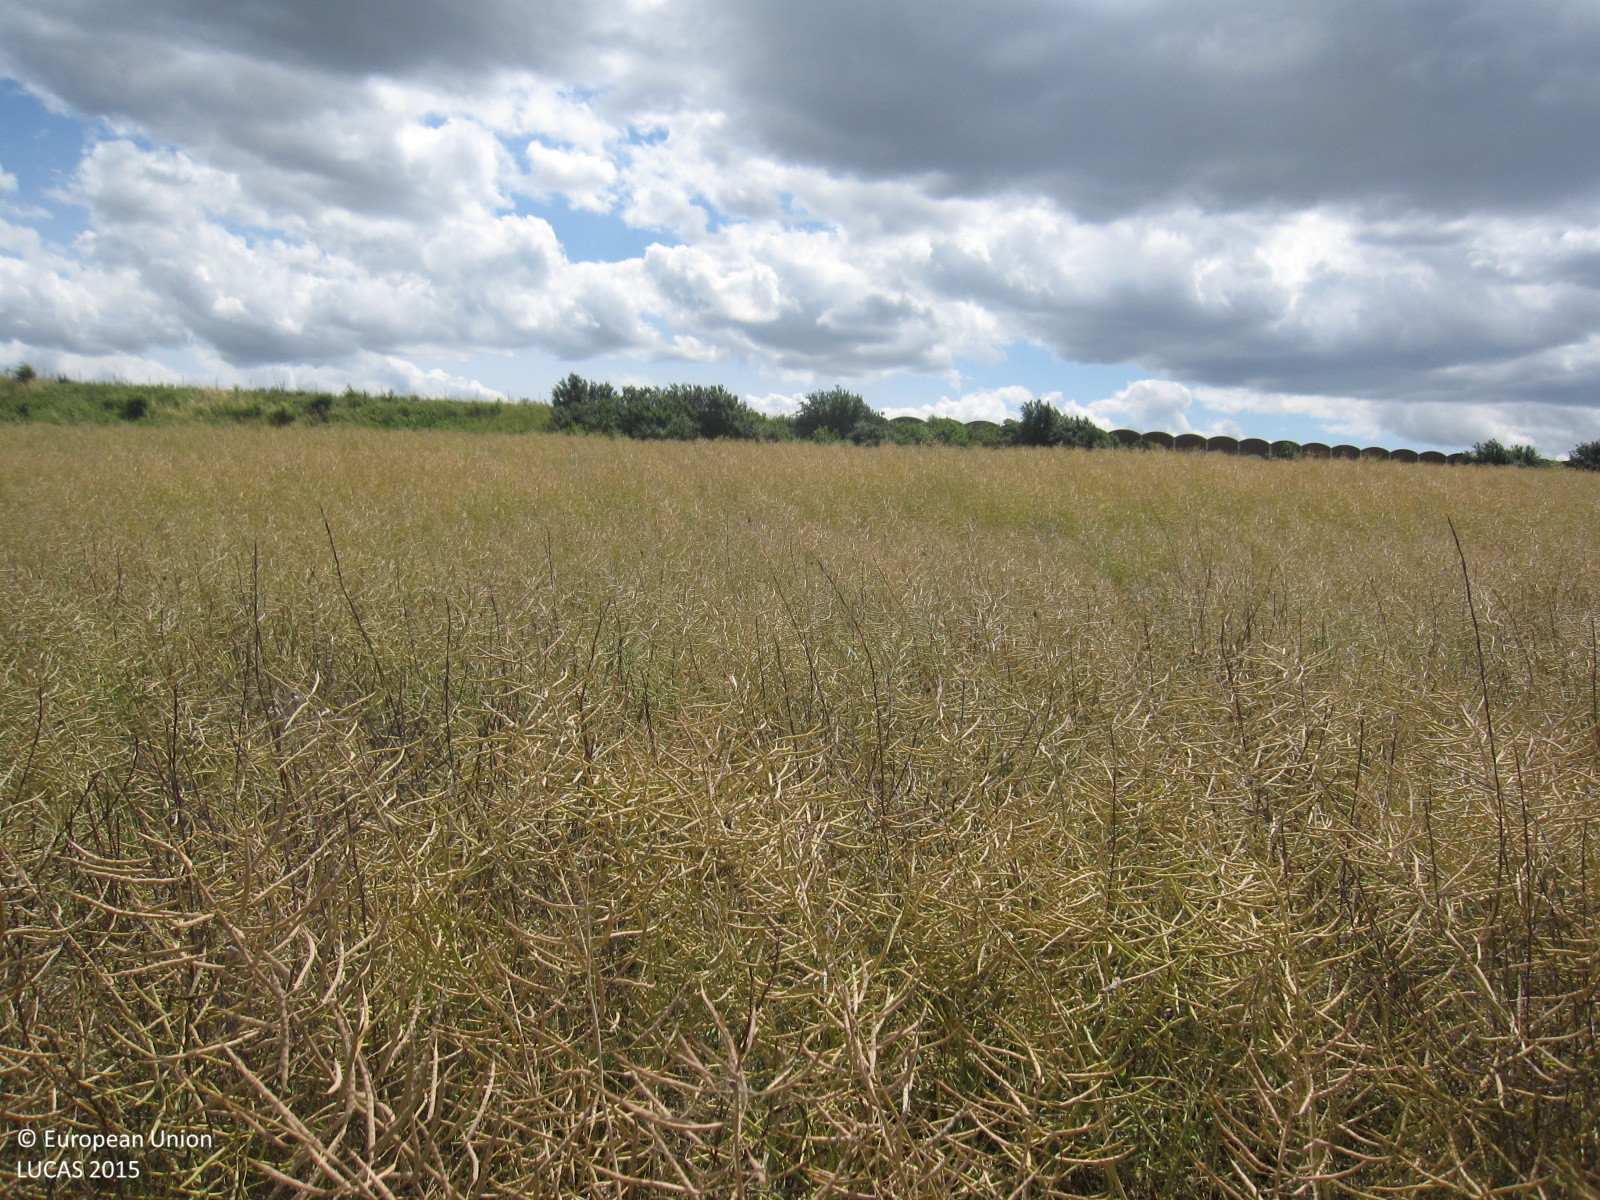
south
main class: Cropland
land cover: Rape and turnip rape
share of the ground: > 75 %
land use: Agriculture (excluding fallow land and kitchen gardens)
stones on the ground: < 10 %
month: July
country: DE
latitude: 50.9040
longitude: 12.0047
